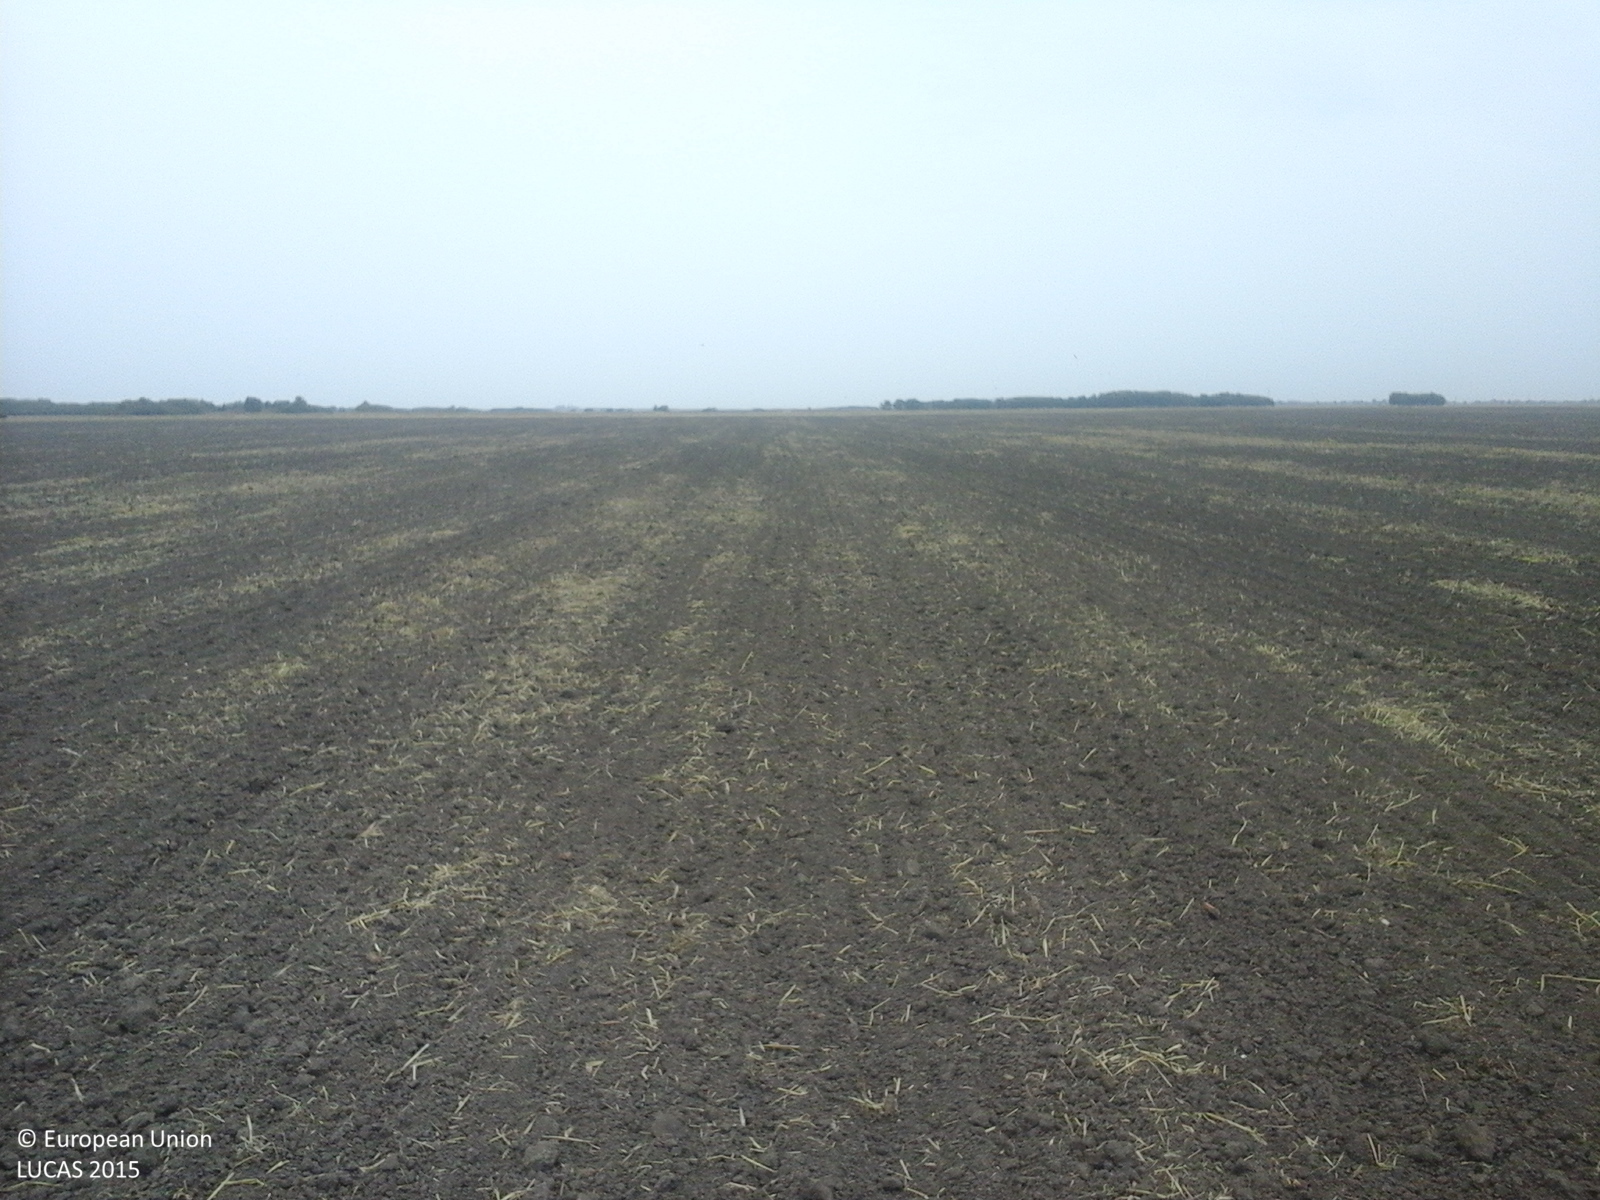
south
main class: Cropland
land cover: Common wheat
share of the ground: < 10 %
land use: Agriculture (excluding fallow land and kitchen gardens)
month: September
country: RO
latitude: 47.6683
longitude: 22.5372
